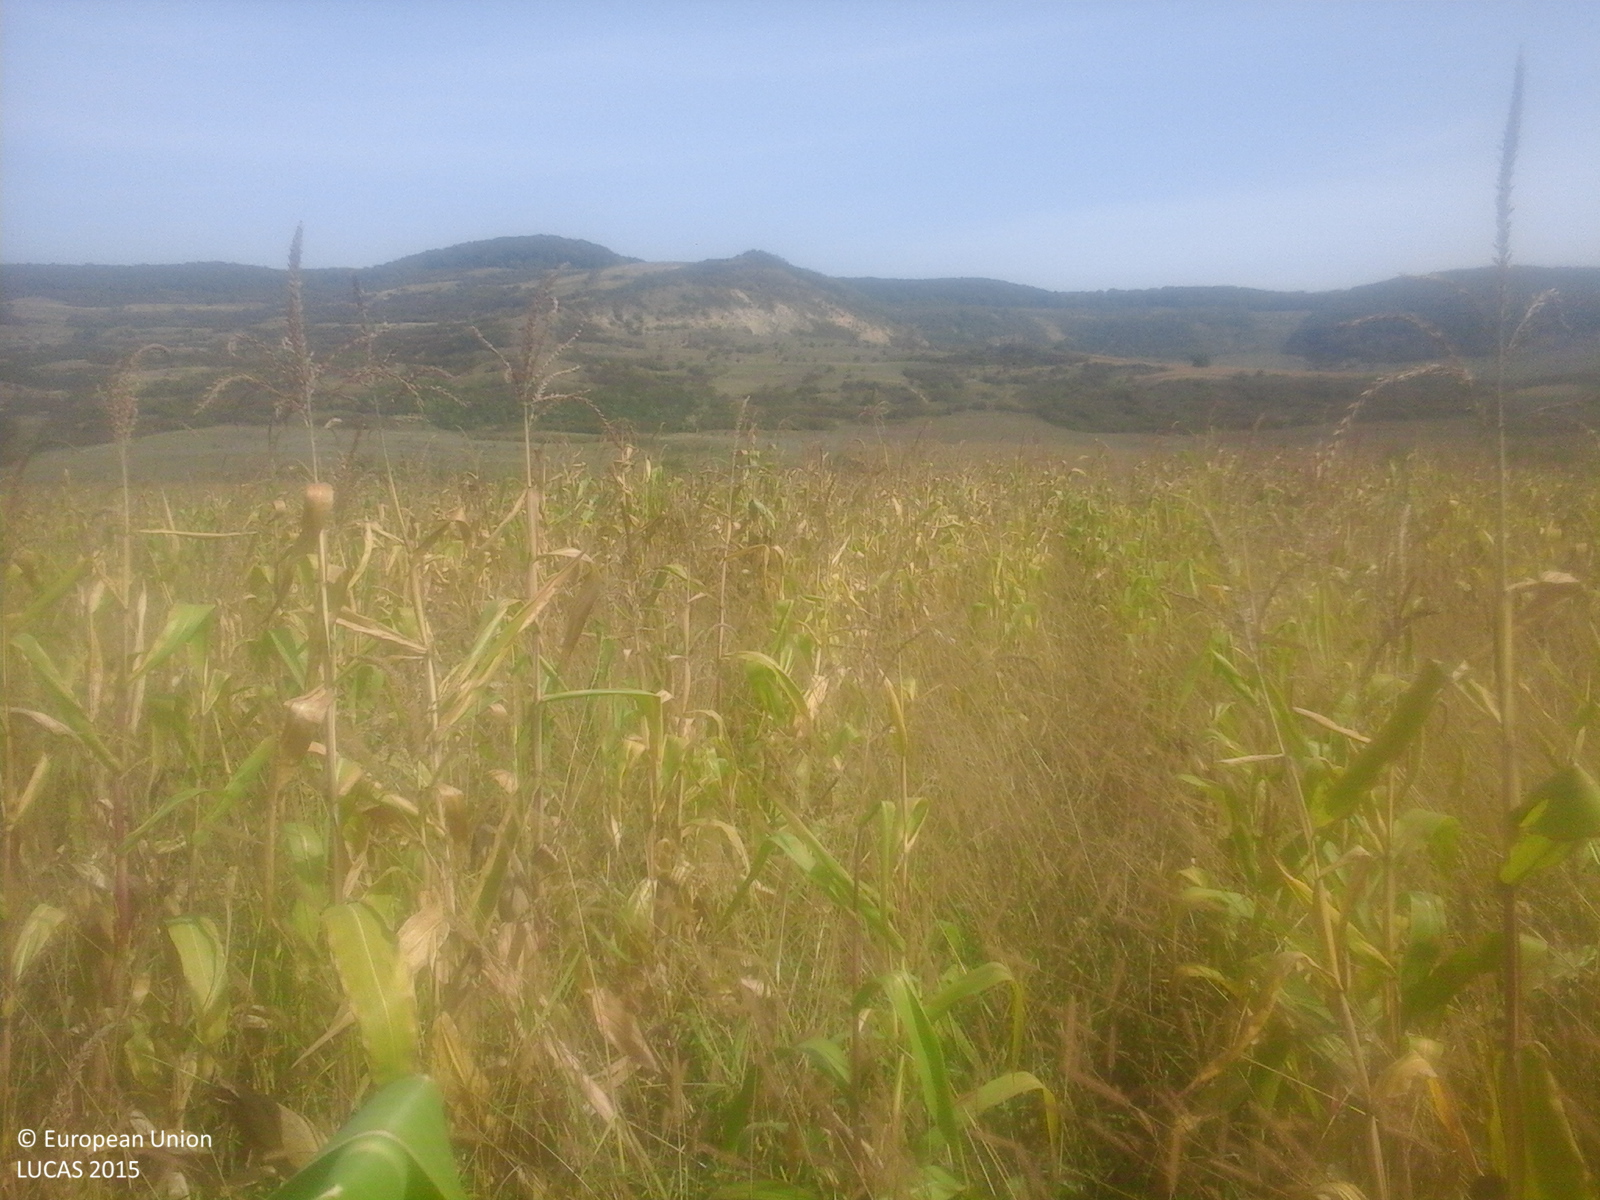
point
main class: Cropland
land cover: Maize
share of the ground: > 75 %
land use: Agriculture (excluding fallow land and kitchen gardens)
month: September
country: RO
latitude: 47.0421
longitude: 24.3410
